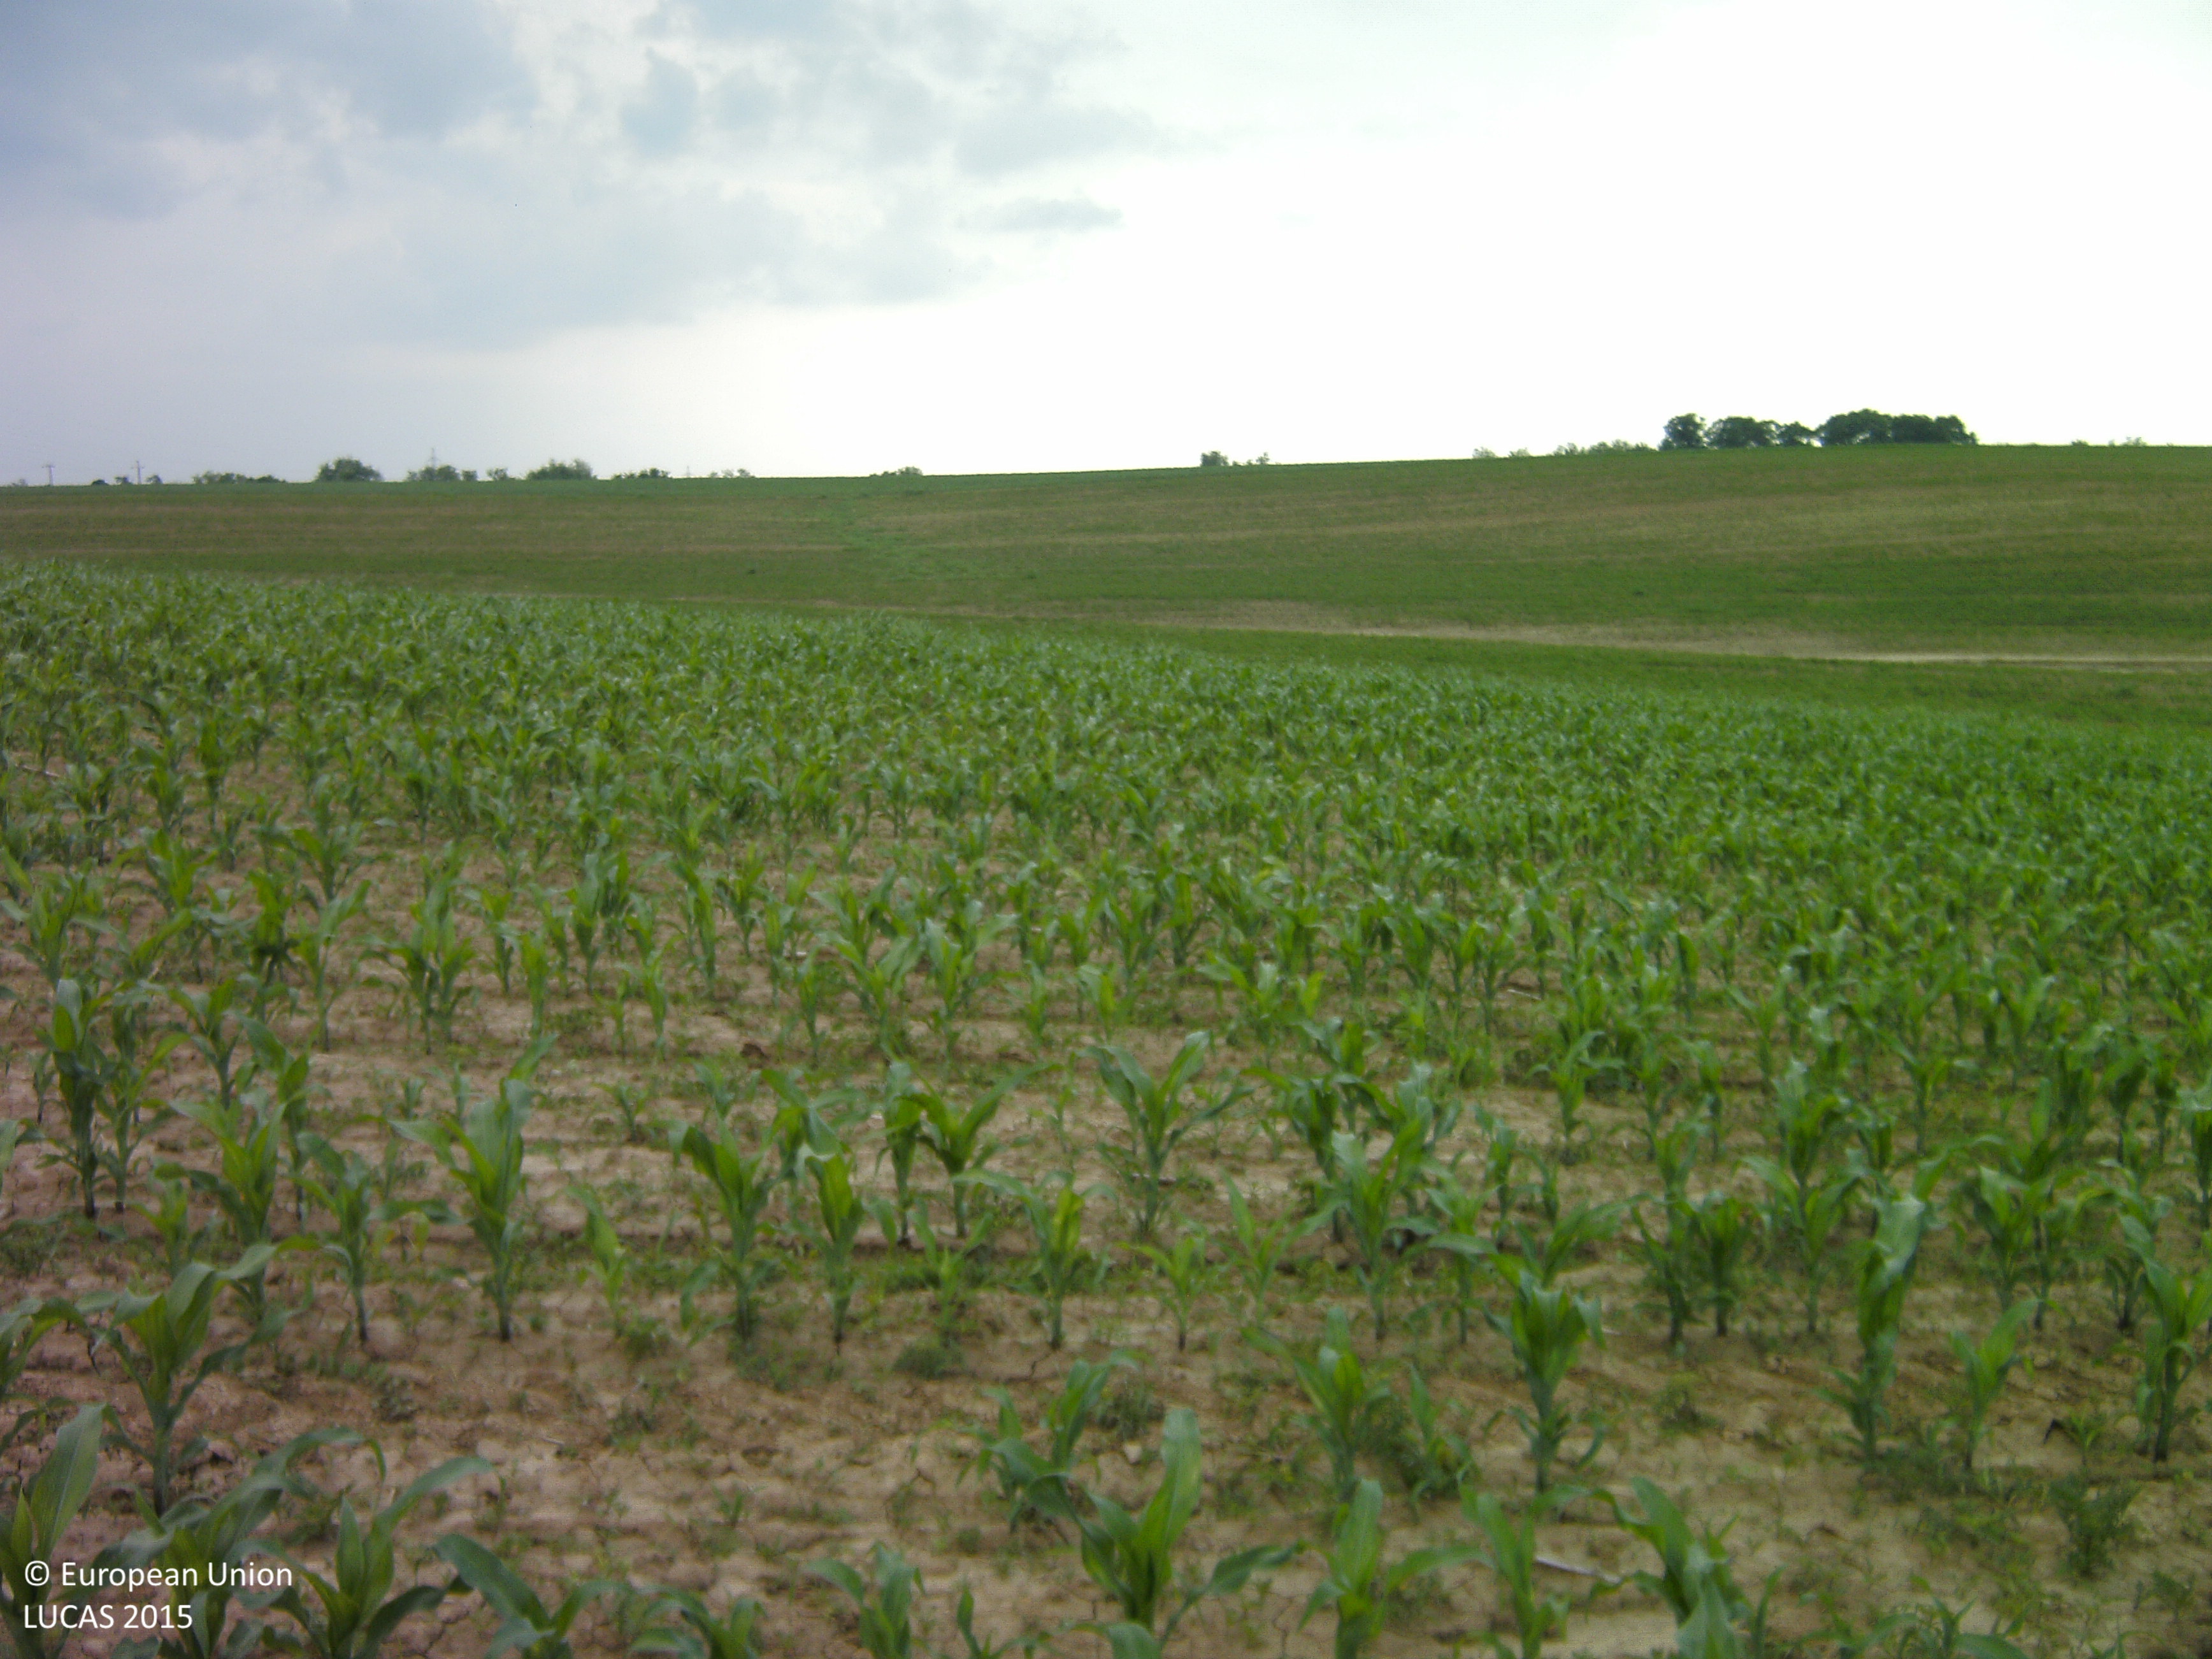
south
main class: Cropland
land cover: Maize
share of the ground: 25 - 50 %
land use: Agriculture (excluding fallow land and kitchen gardens)
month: June
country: HU
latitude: 46.4081
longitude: 17.8242
